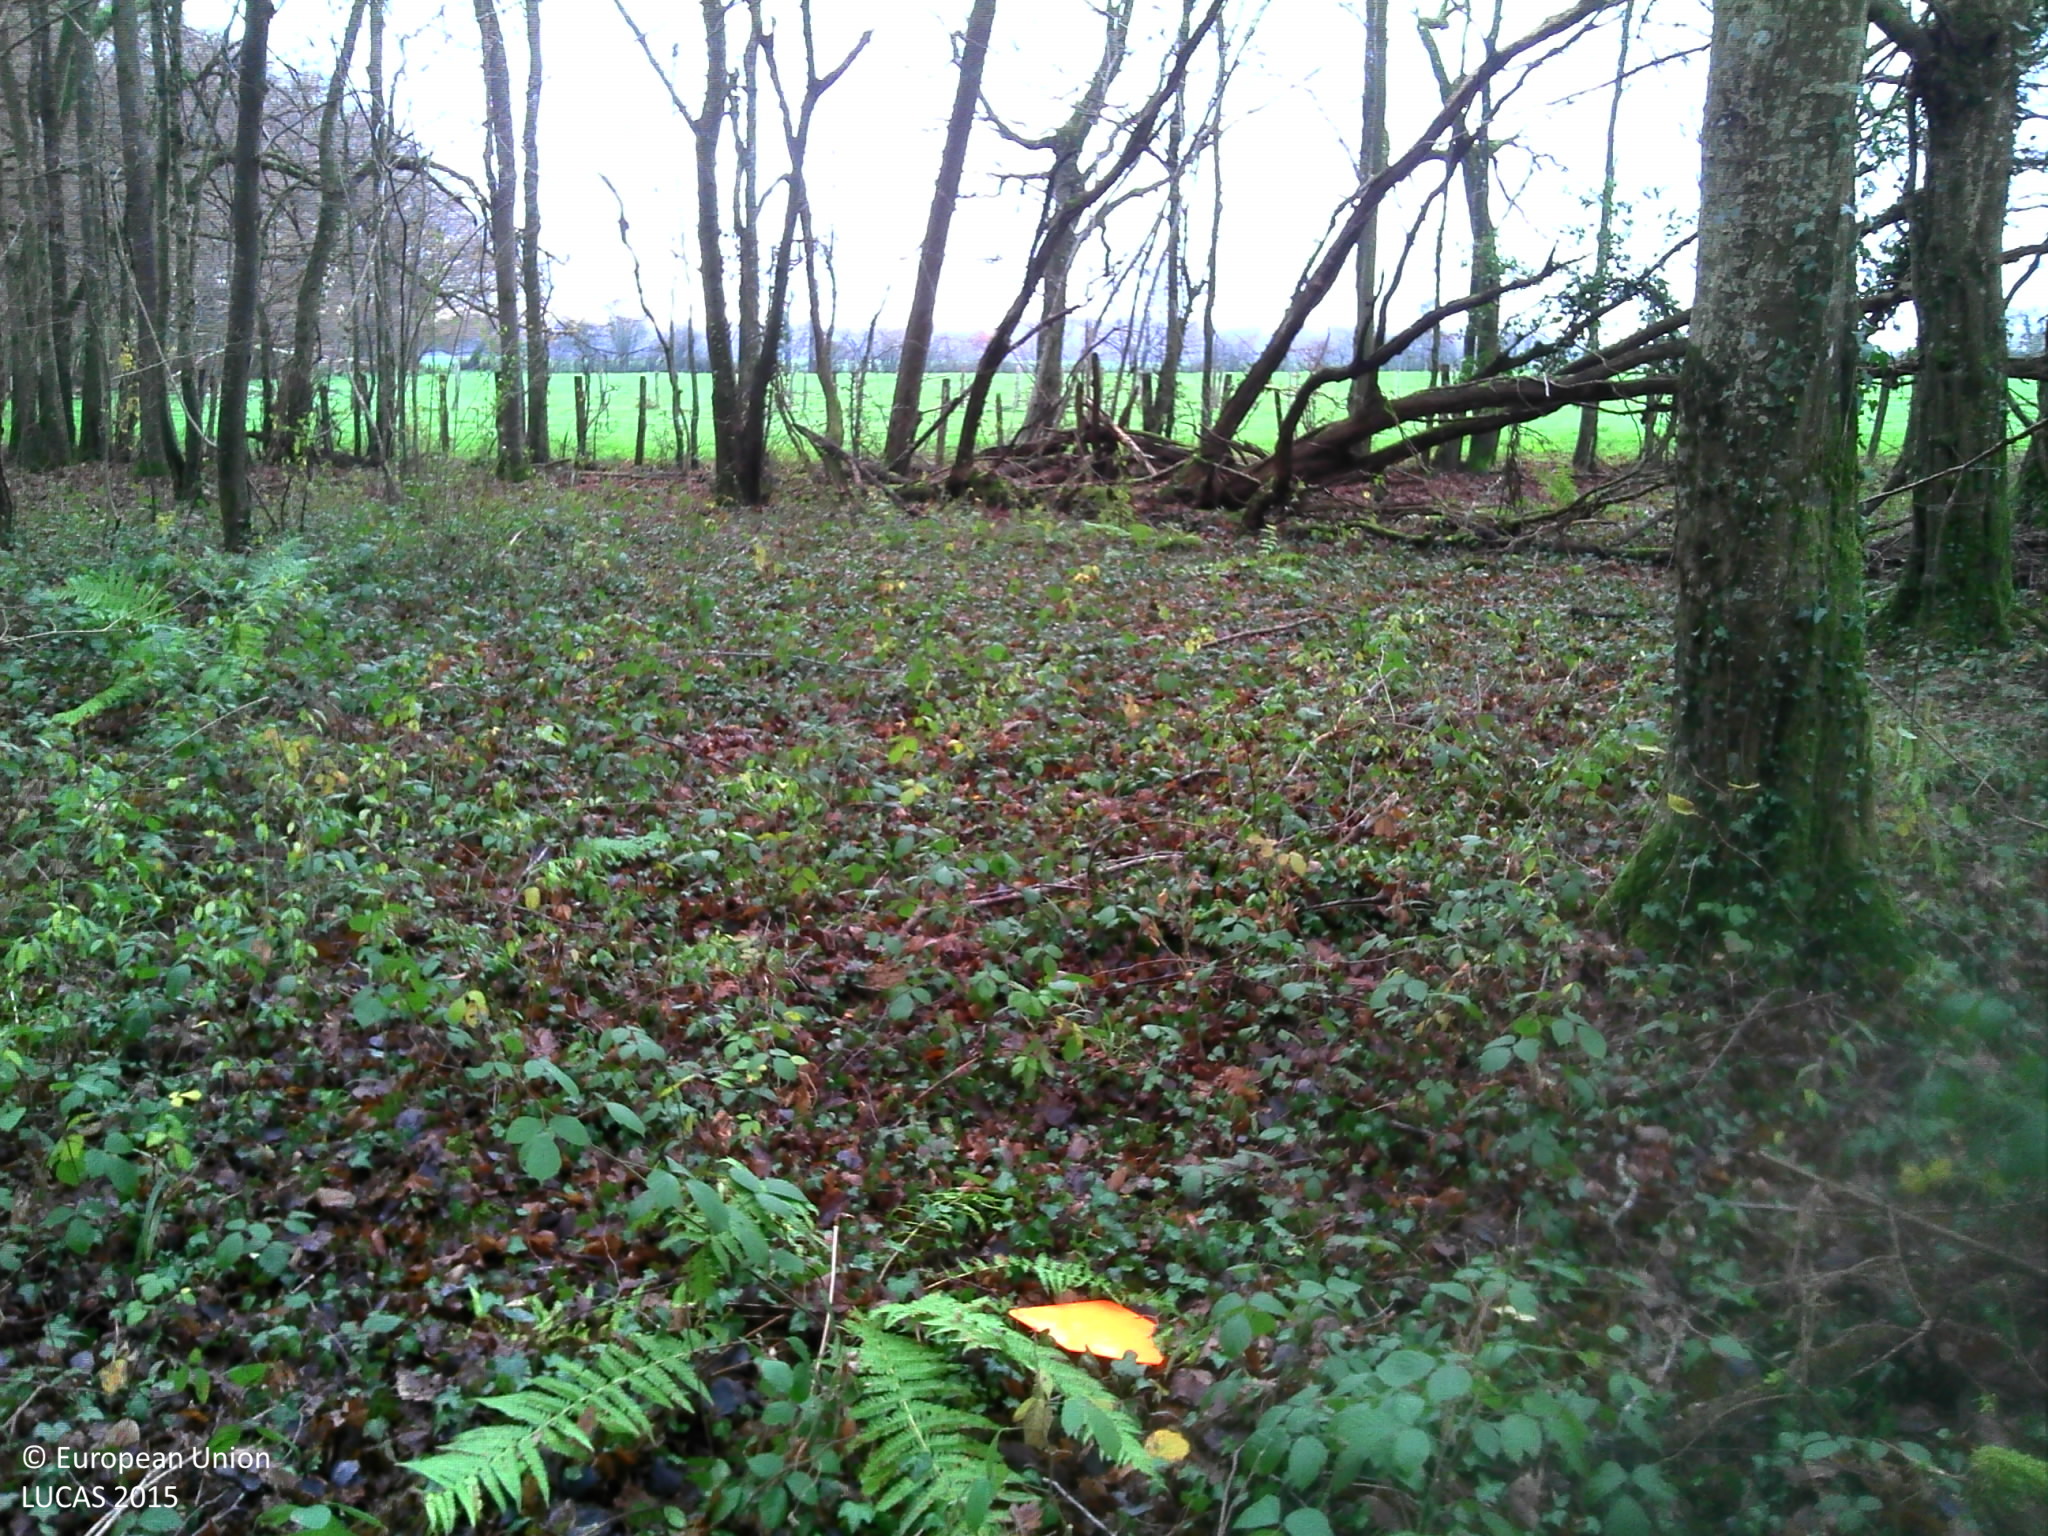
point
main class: Woodland
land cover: Broadleaved woodland
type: mesophytic deciduous forest
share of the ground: > 75 %
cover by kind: broadleaved forest trees 100 %
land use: Forestry
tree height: > 5 m
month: December
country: FR
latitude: 47.0562
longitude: 5.2224
